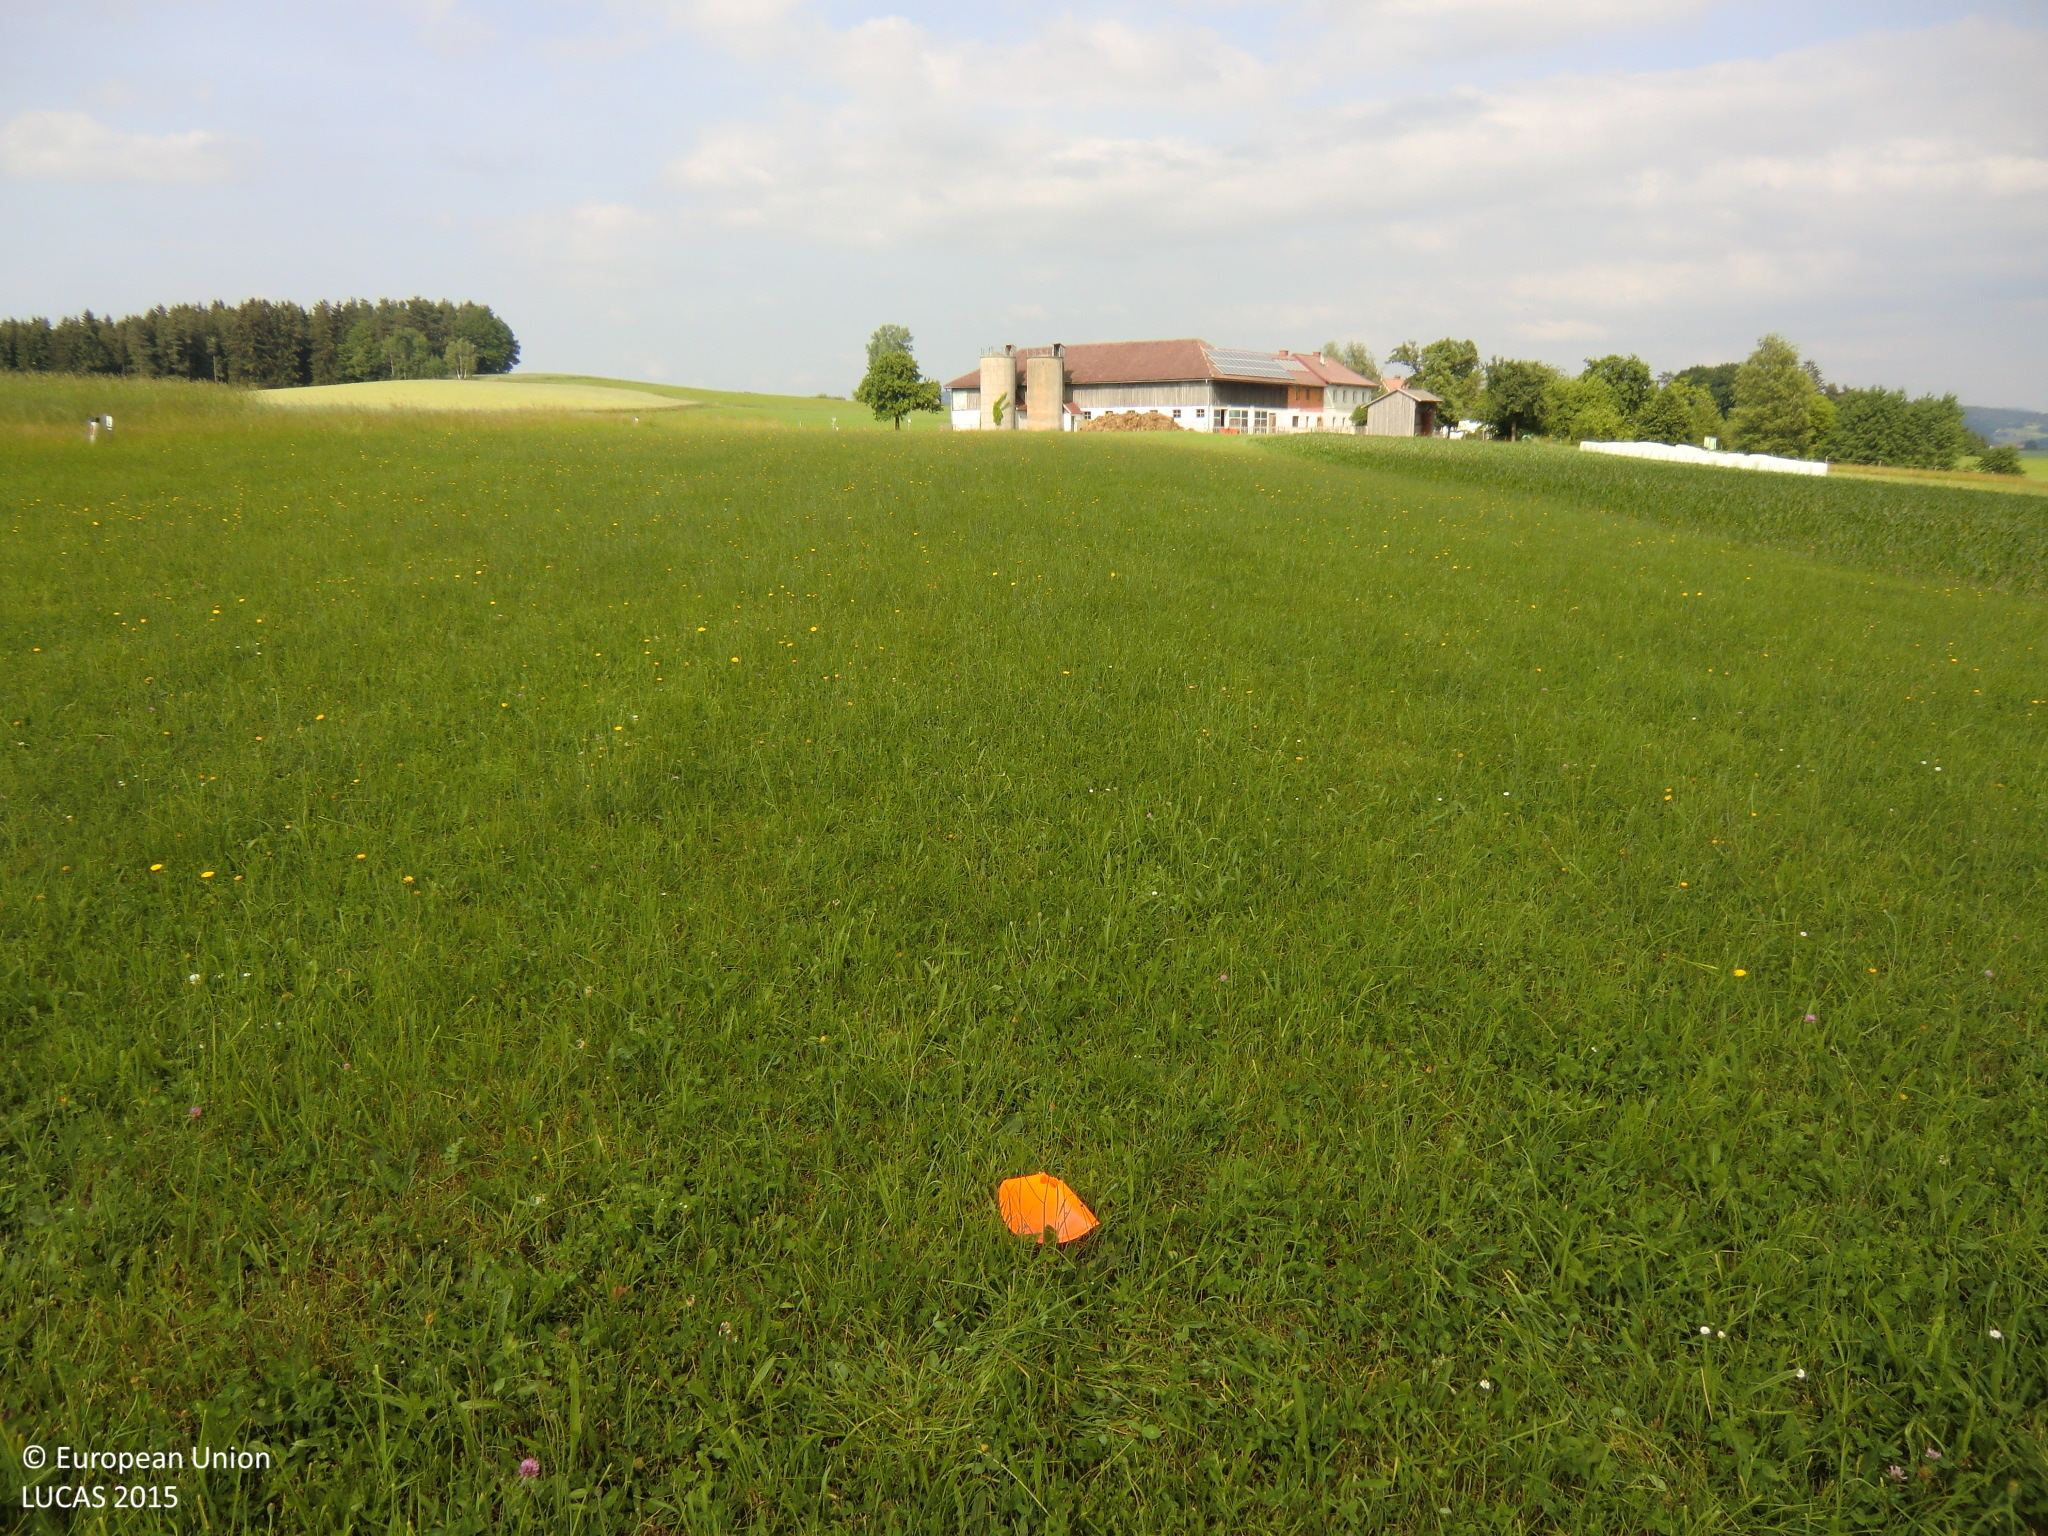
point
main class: Grassland
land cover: Grassland without tree/shrub cover
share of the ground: > 75 %
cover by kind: herbaceous plants 100 %
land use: Agriculture (excluding fallow land and kitchen gardens)
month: June
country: AT
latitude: 48.3606
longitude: 14.6301
